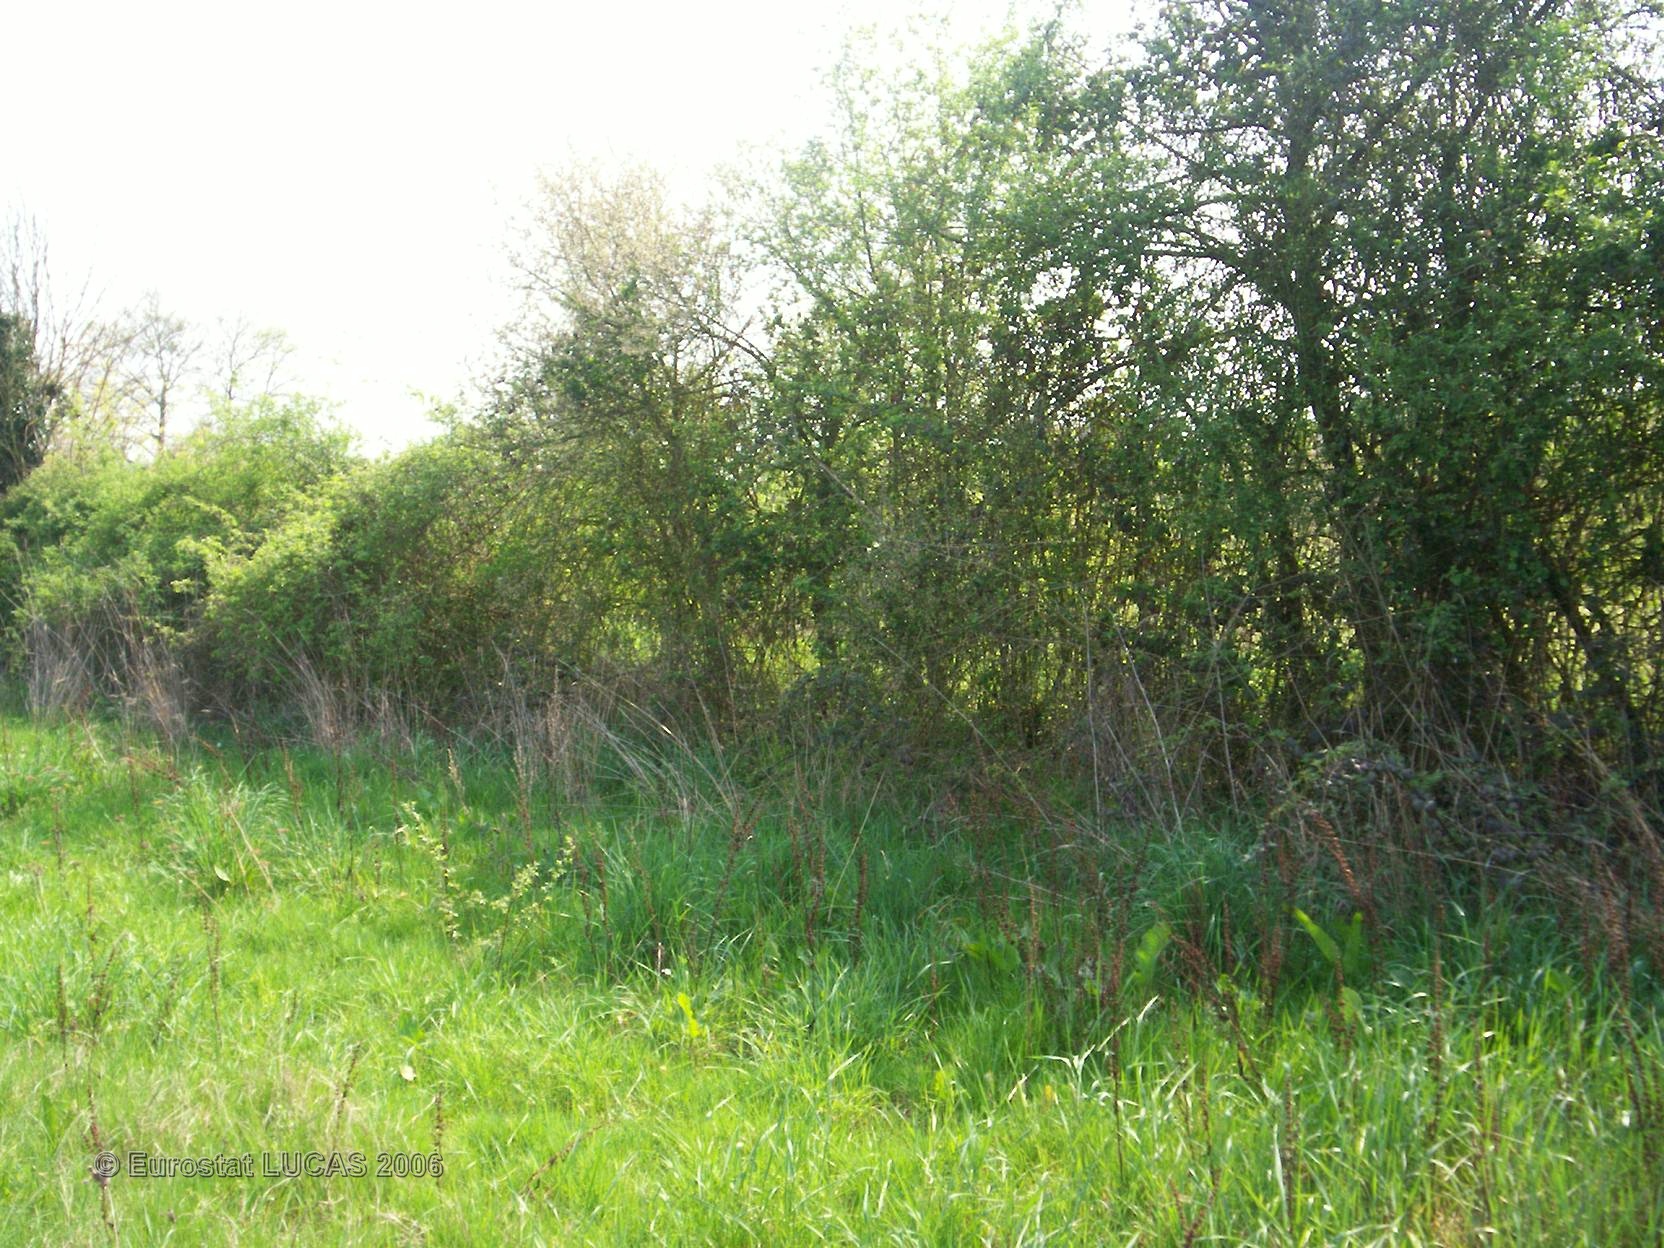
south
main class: Grassland
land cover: Grassland without tree/shrub cover
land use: Agriculture (excluding fallow land and kitchen gardens)
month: April
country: FR
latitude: 48.0286
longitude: 0.2792
